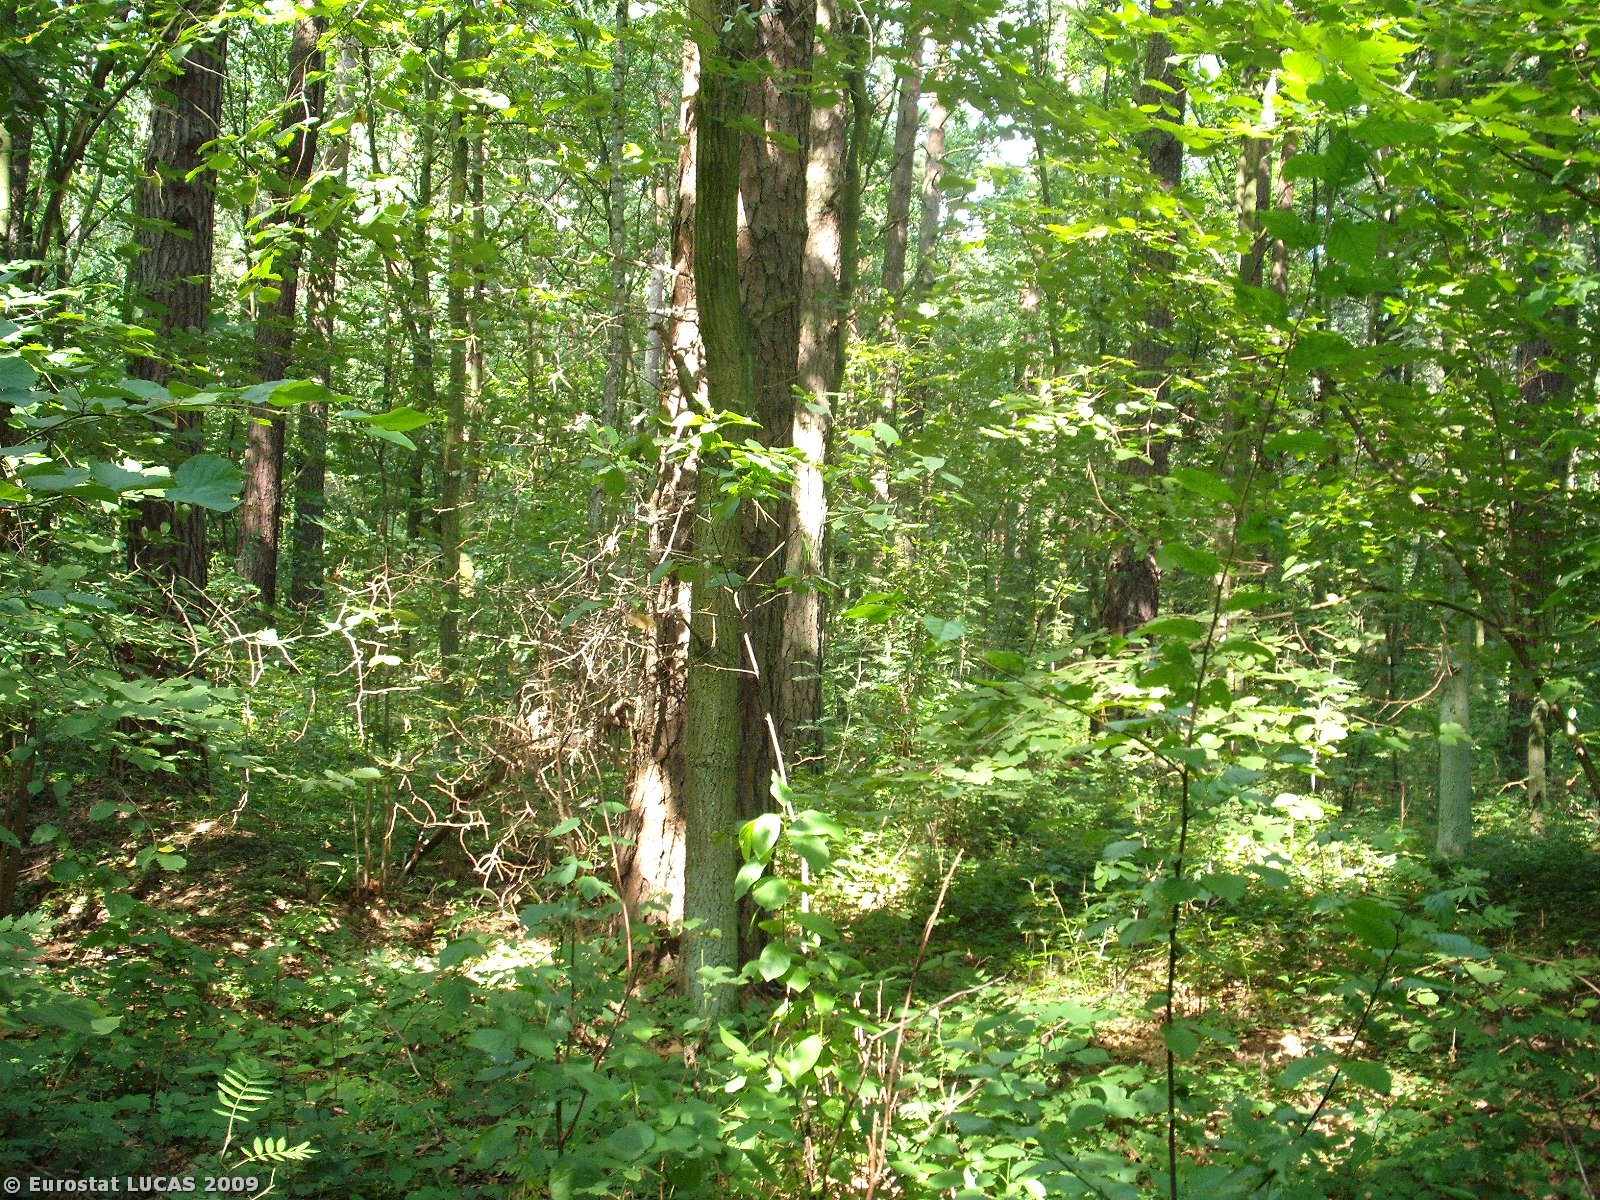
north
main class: Woodland
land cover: Mixed woodland
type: hemiboreal forest and nemoral coniferous forest and mixed broadleaved-coniferous forest
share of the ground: > 75 %
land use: Forestry
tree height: > 5 m
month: August
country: PL
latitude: 51.8111
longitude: 21.5542
